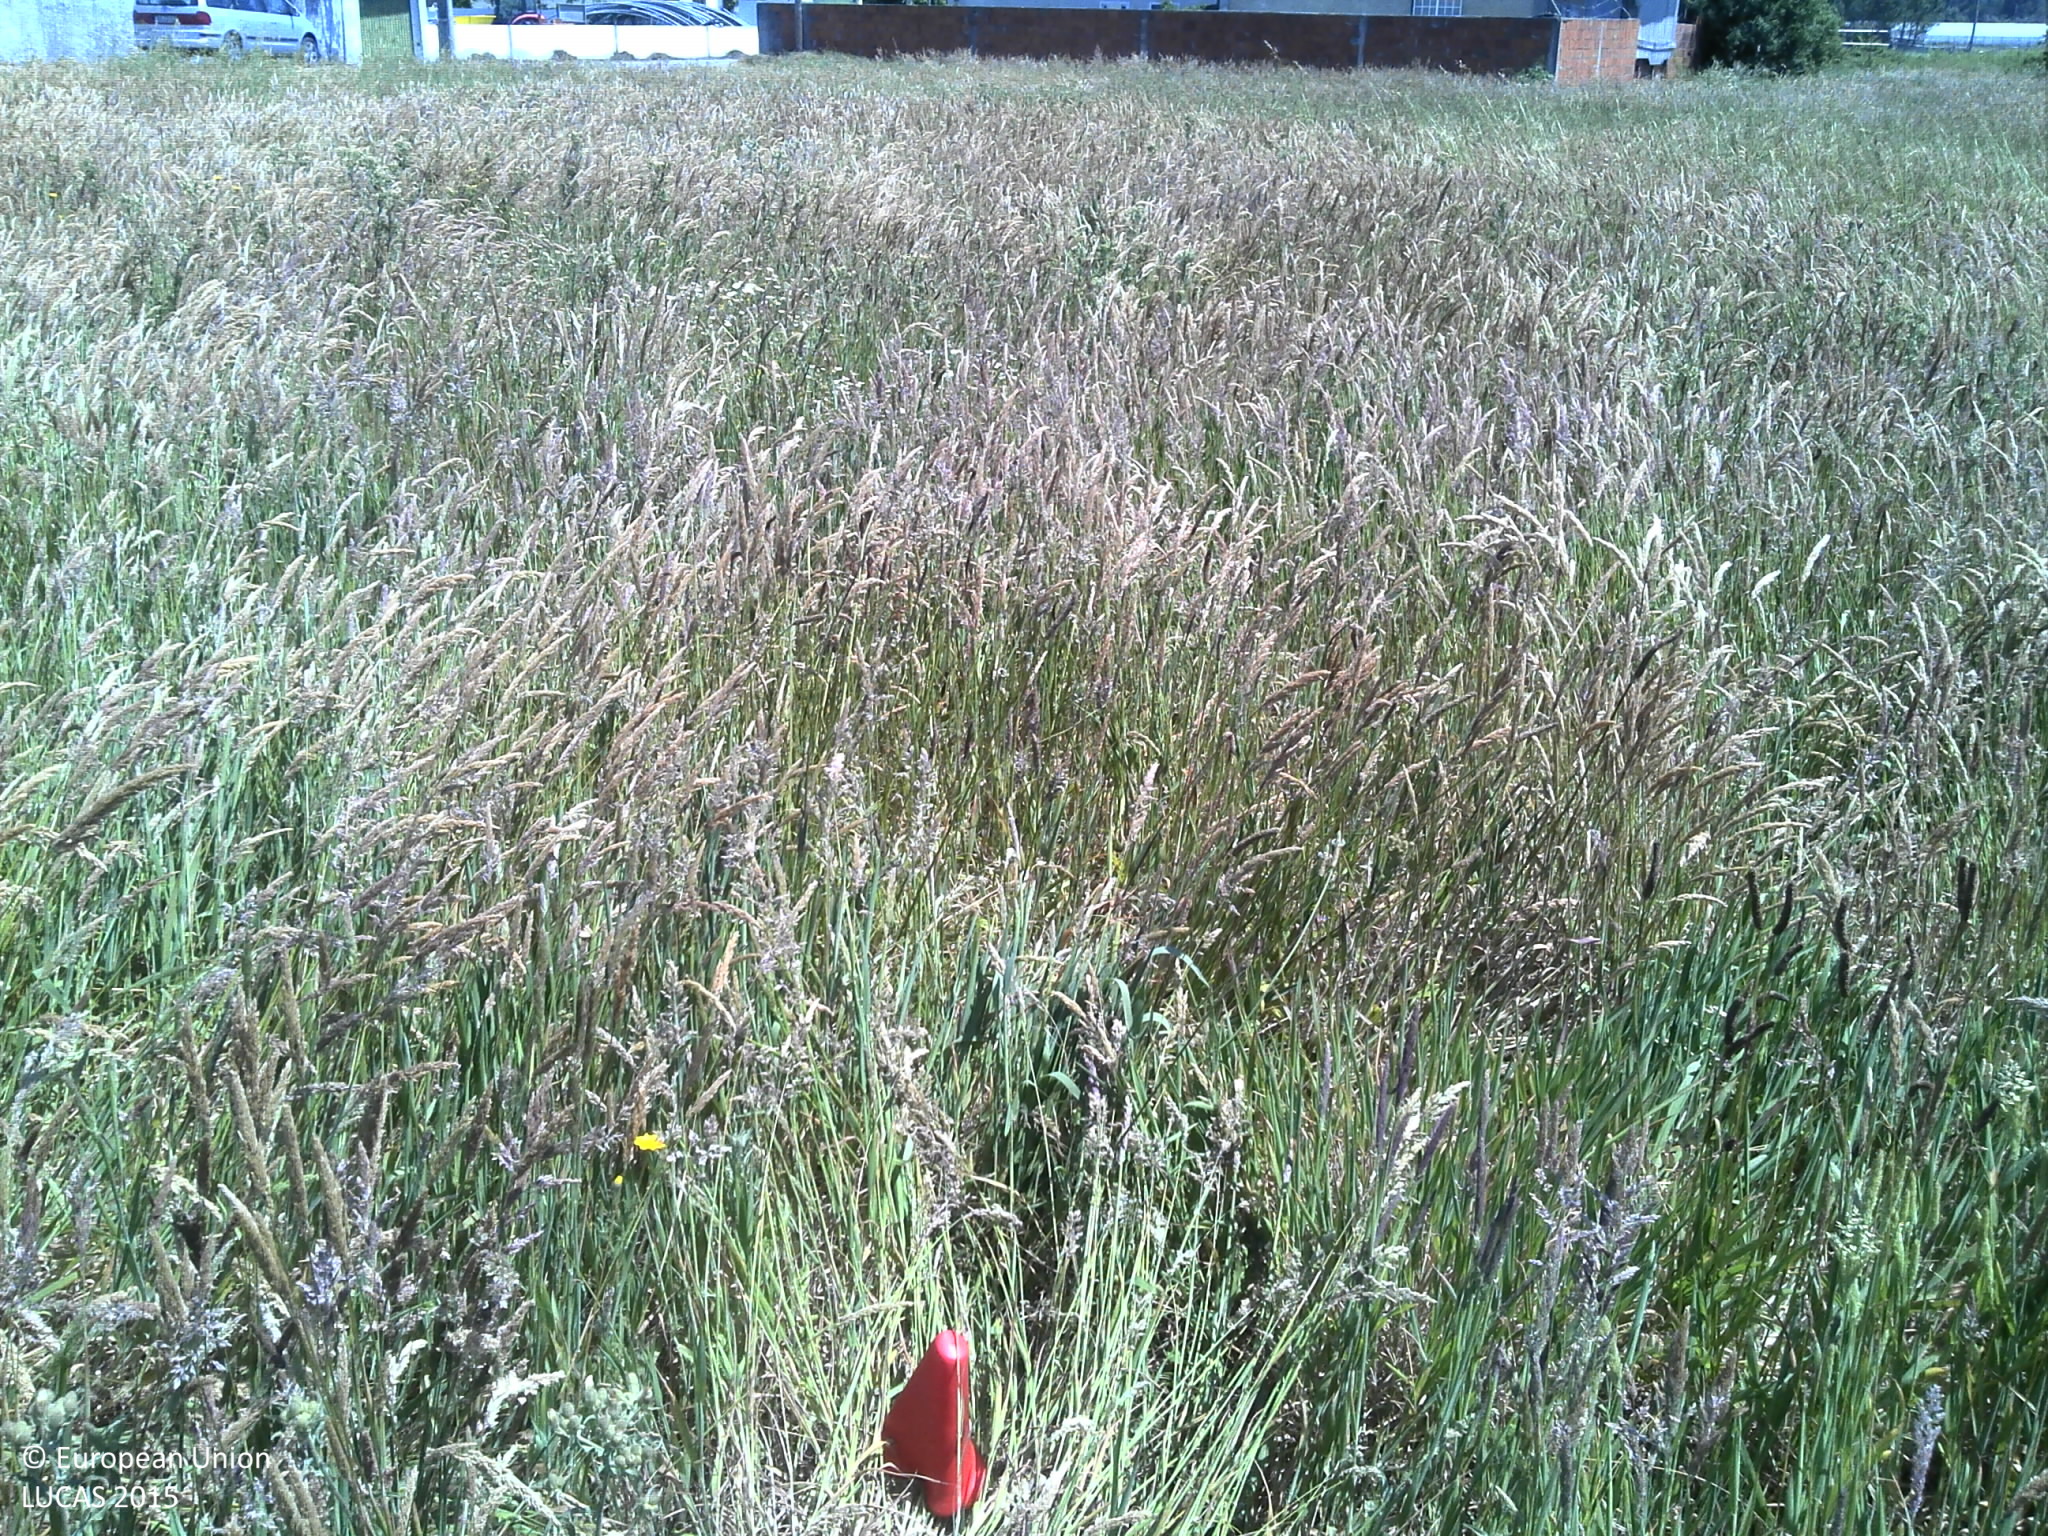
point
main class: Grassland
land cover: Grassland without tree/shrub cover
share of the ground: 50 - 75 %
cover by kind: herbaceous plants 75 %, unconsolidated bare surface 25 %
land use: Agriculture (excluding fallow land and kitchen gardens)
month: May
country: PT
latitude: 40.4693
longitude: -8.6956
